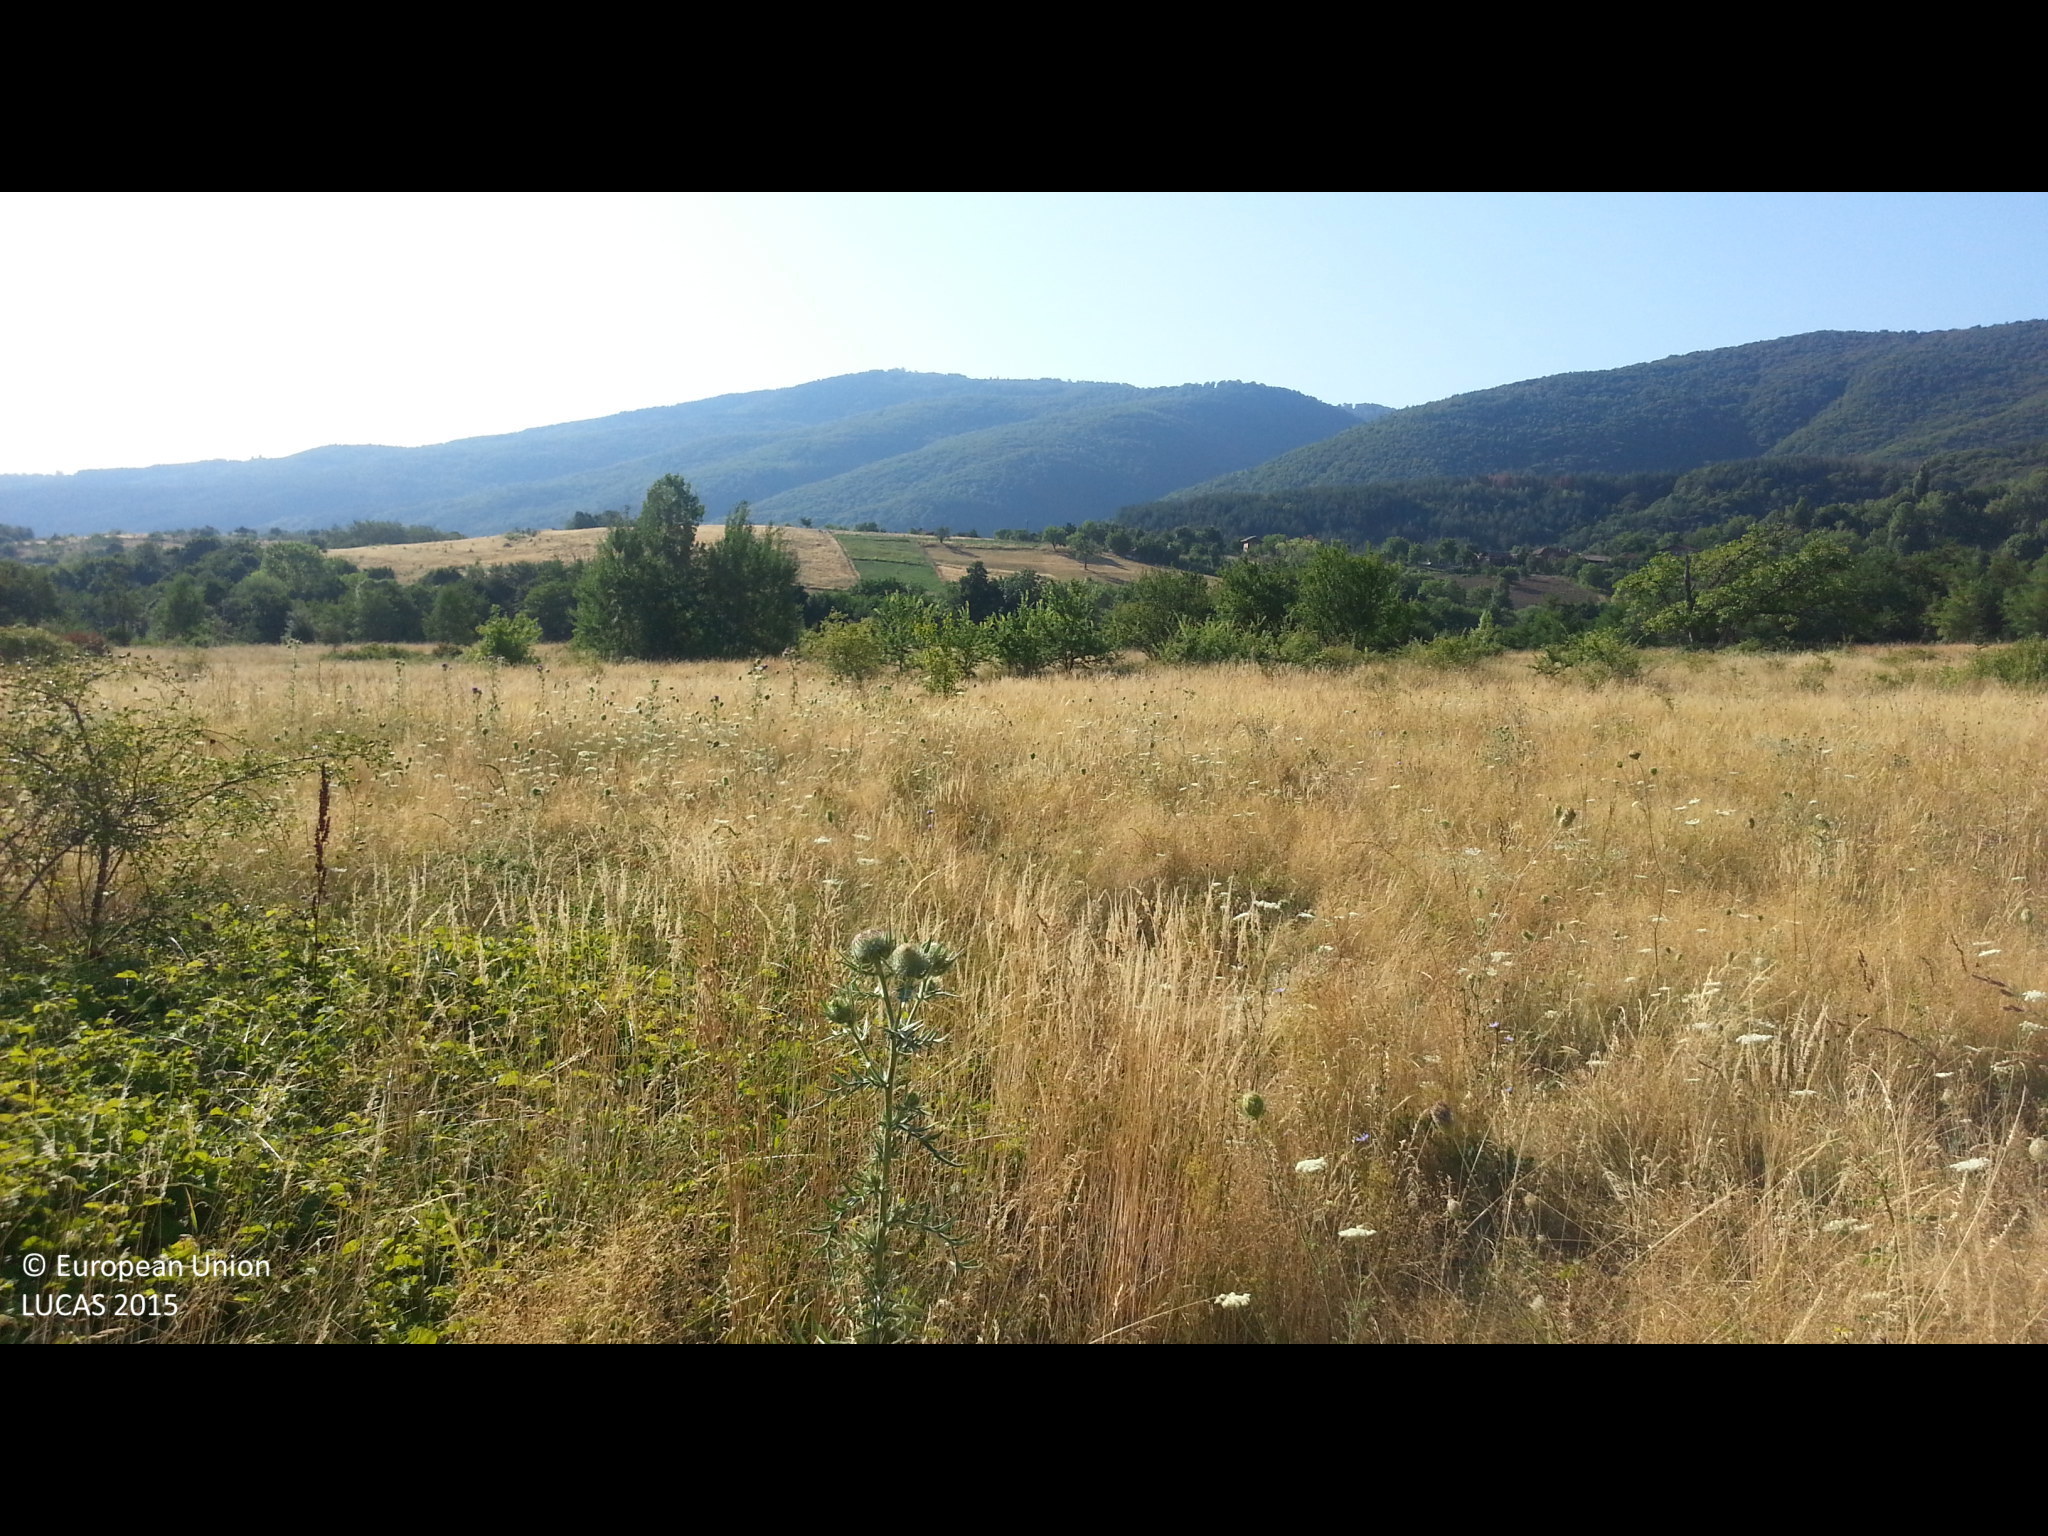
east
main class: Grassland
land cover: Grassland without tree/shrub cover
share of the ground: > 75 %
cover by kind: herbaceous plants 95 %, shrubs 5 %
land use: Semi-natural and natural areas not in use
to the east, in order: Grassland without tree/shrub cover; Grassland with sparse tree/shrub cover; Tracks; Grassland without tree/shrub cover
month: August
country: BG
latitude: 42.2633
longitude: 22.6163
